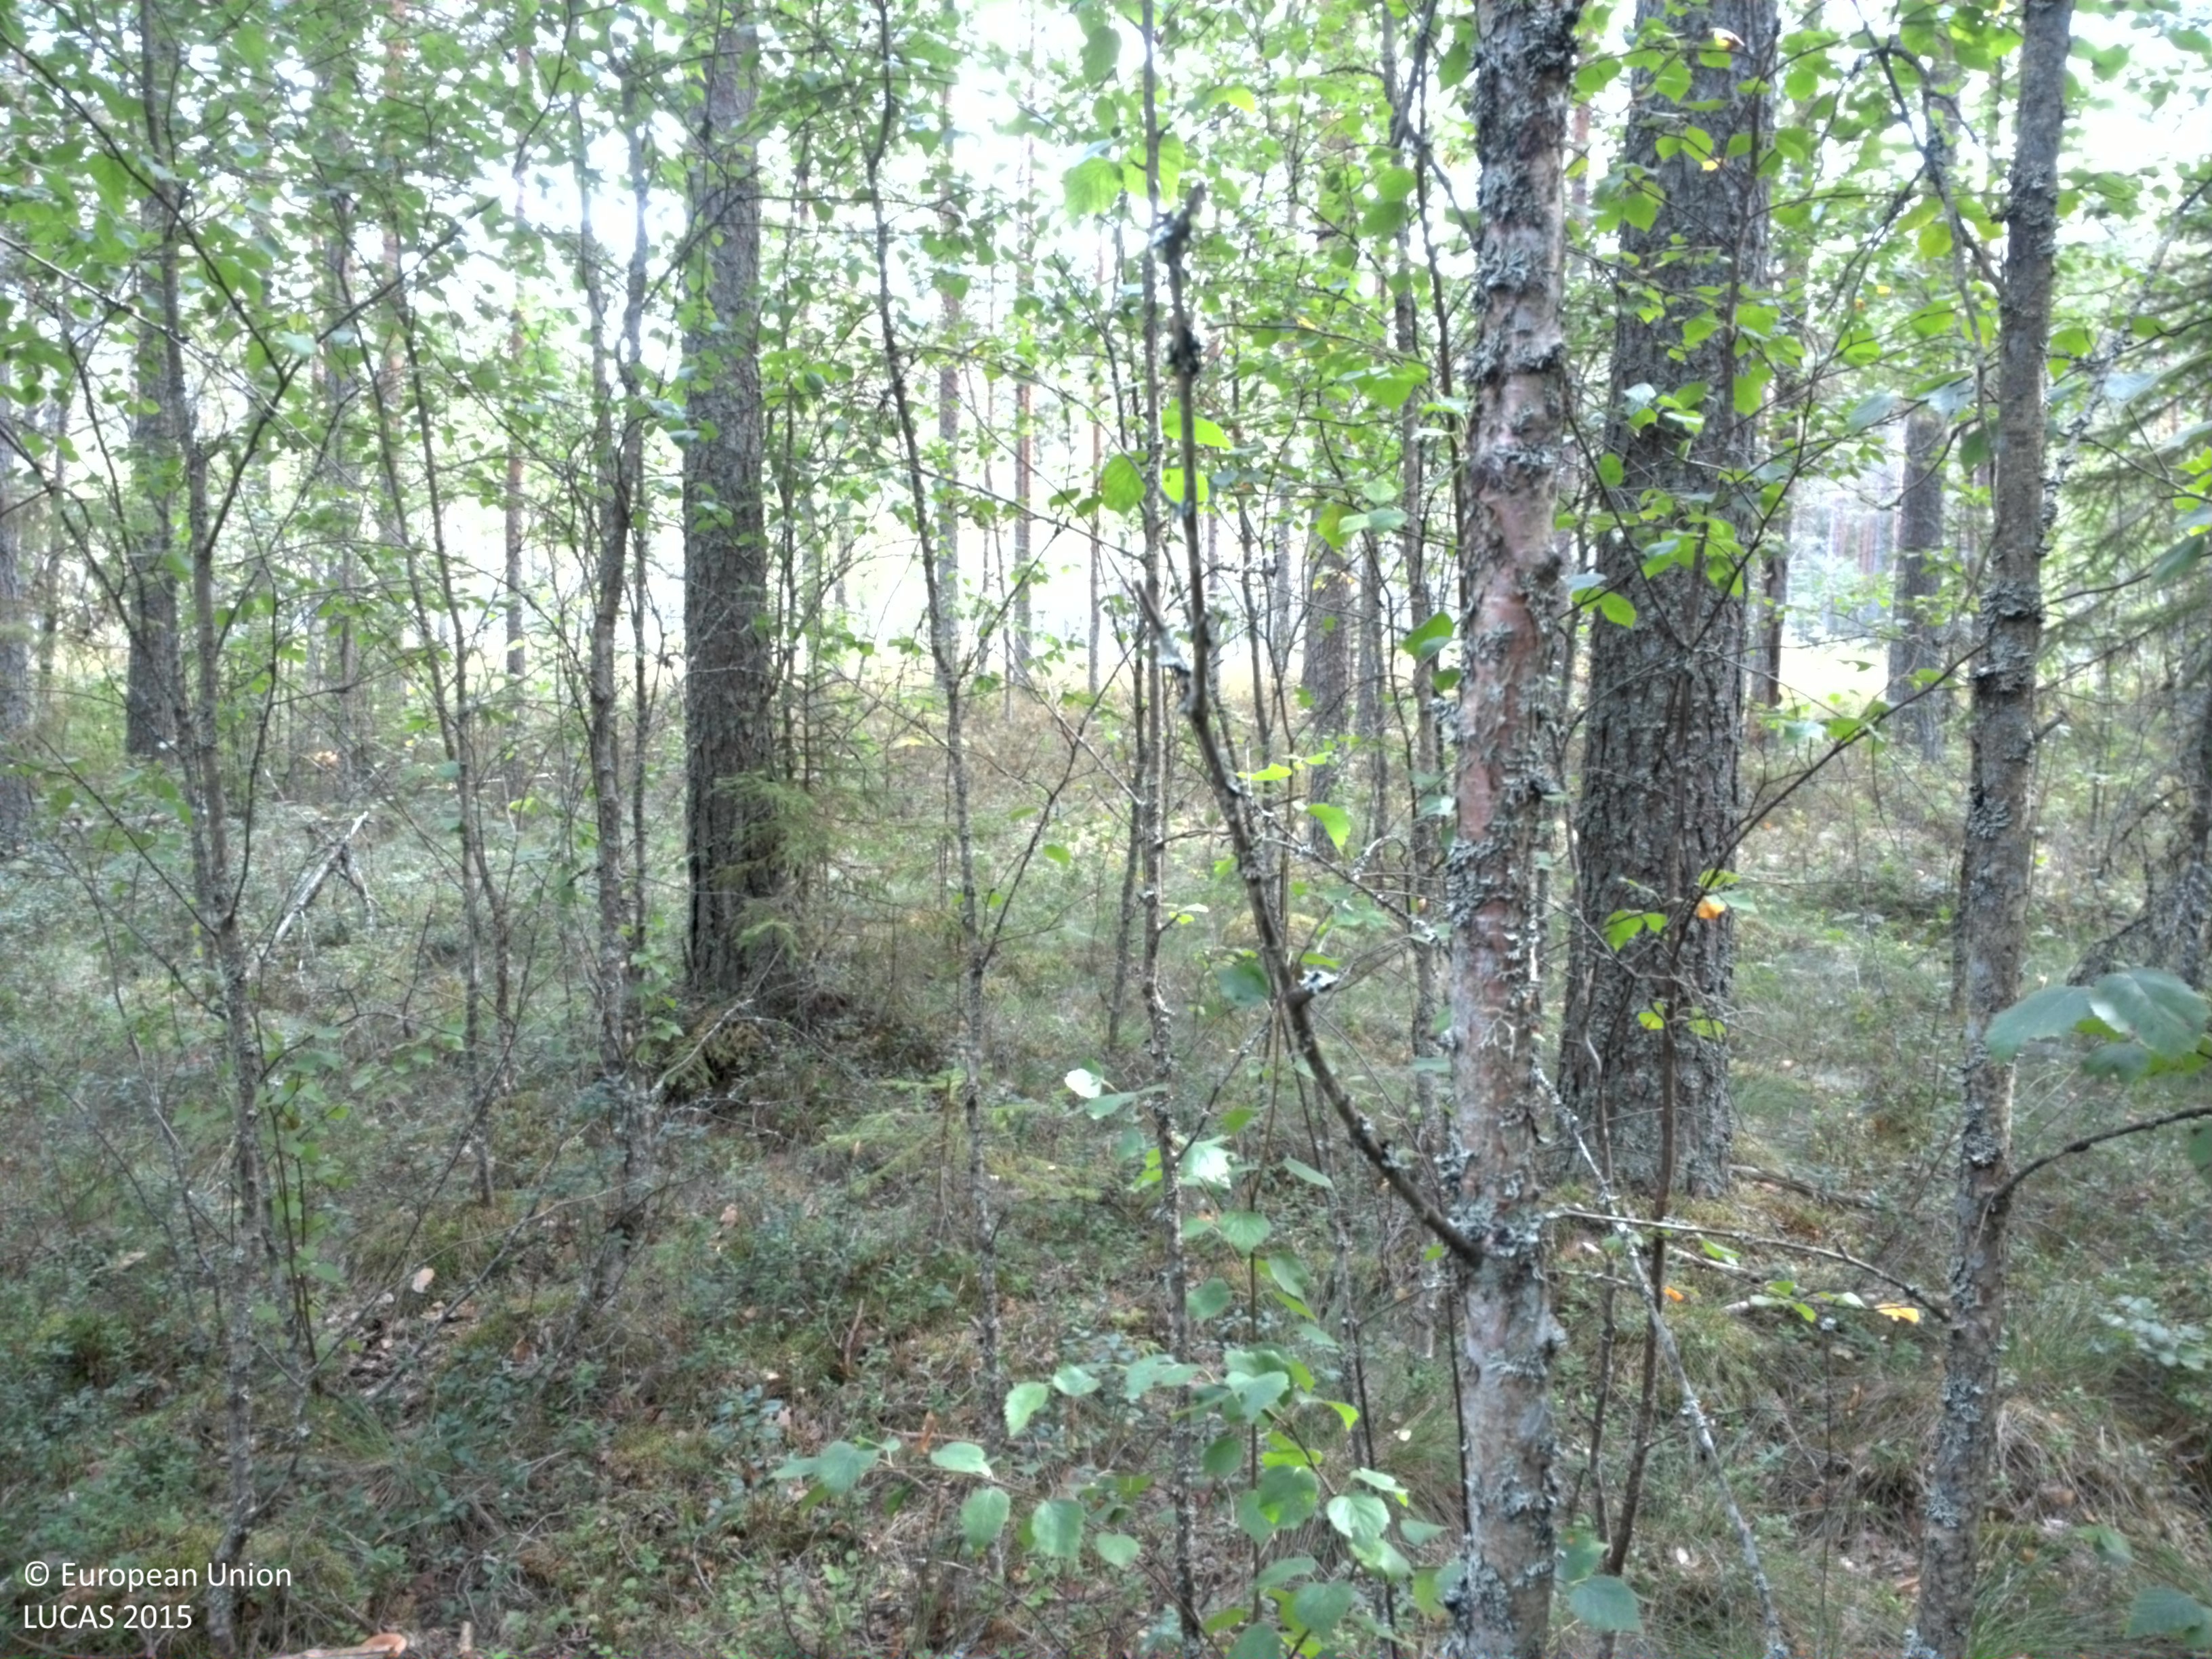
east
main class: Woodland
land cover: Pine dominated mixed woodland
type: boreal forest
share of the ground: 50 - 75 %
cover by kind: coniferous forest trees 40 %, broadleaved forest trees 25 %, shrubs 20 %, lichens and mosses 10 %, herbaceous plants 5 %
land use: Forestry
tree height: > 5 m
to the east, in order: Pine dominated mixed woodland; Peatbogs; Pine dominated coniferous woodland; Other coniferous woodland; Ditches and canals; Other coniferous woodland; Pine dominated mixed woodland
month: August
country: SE
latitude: 59.8883
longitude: 15.6189
